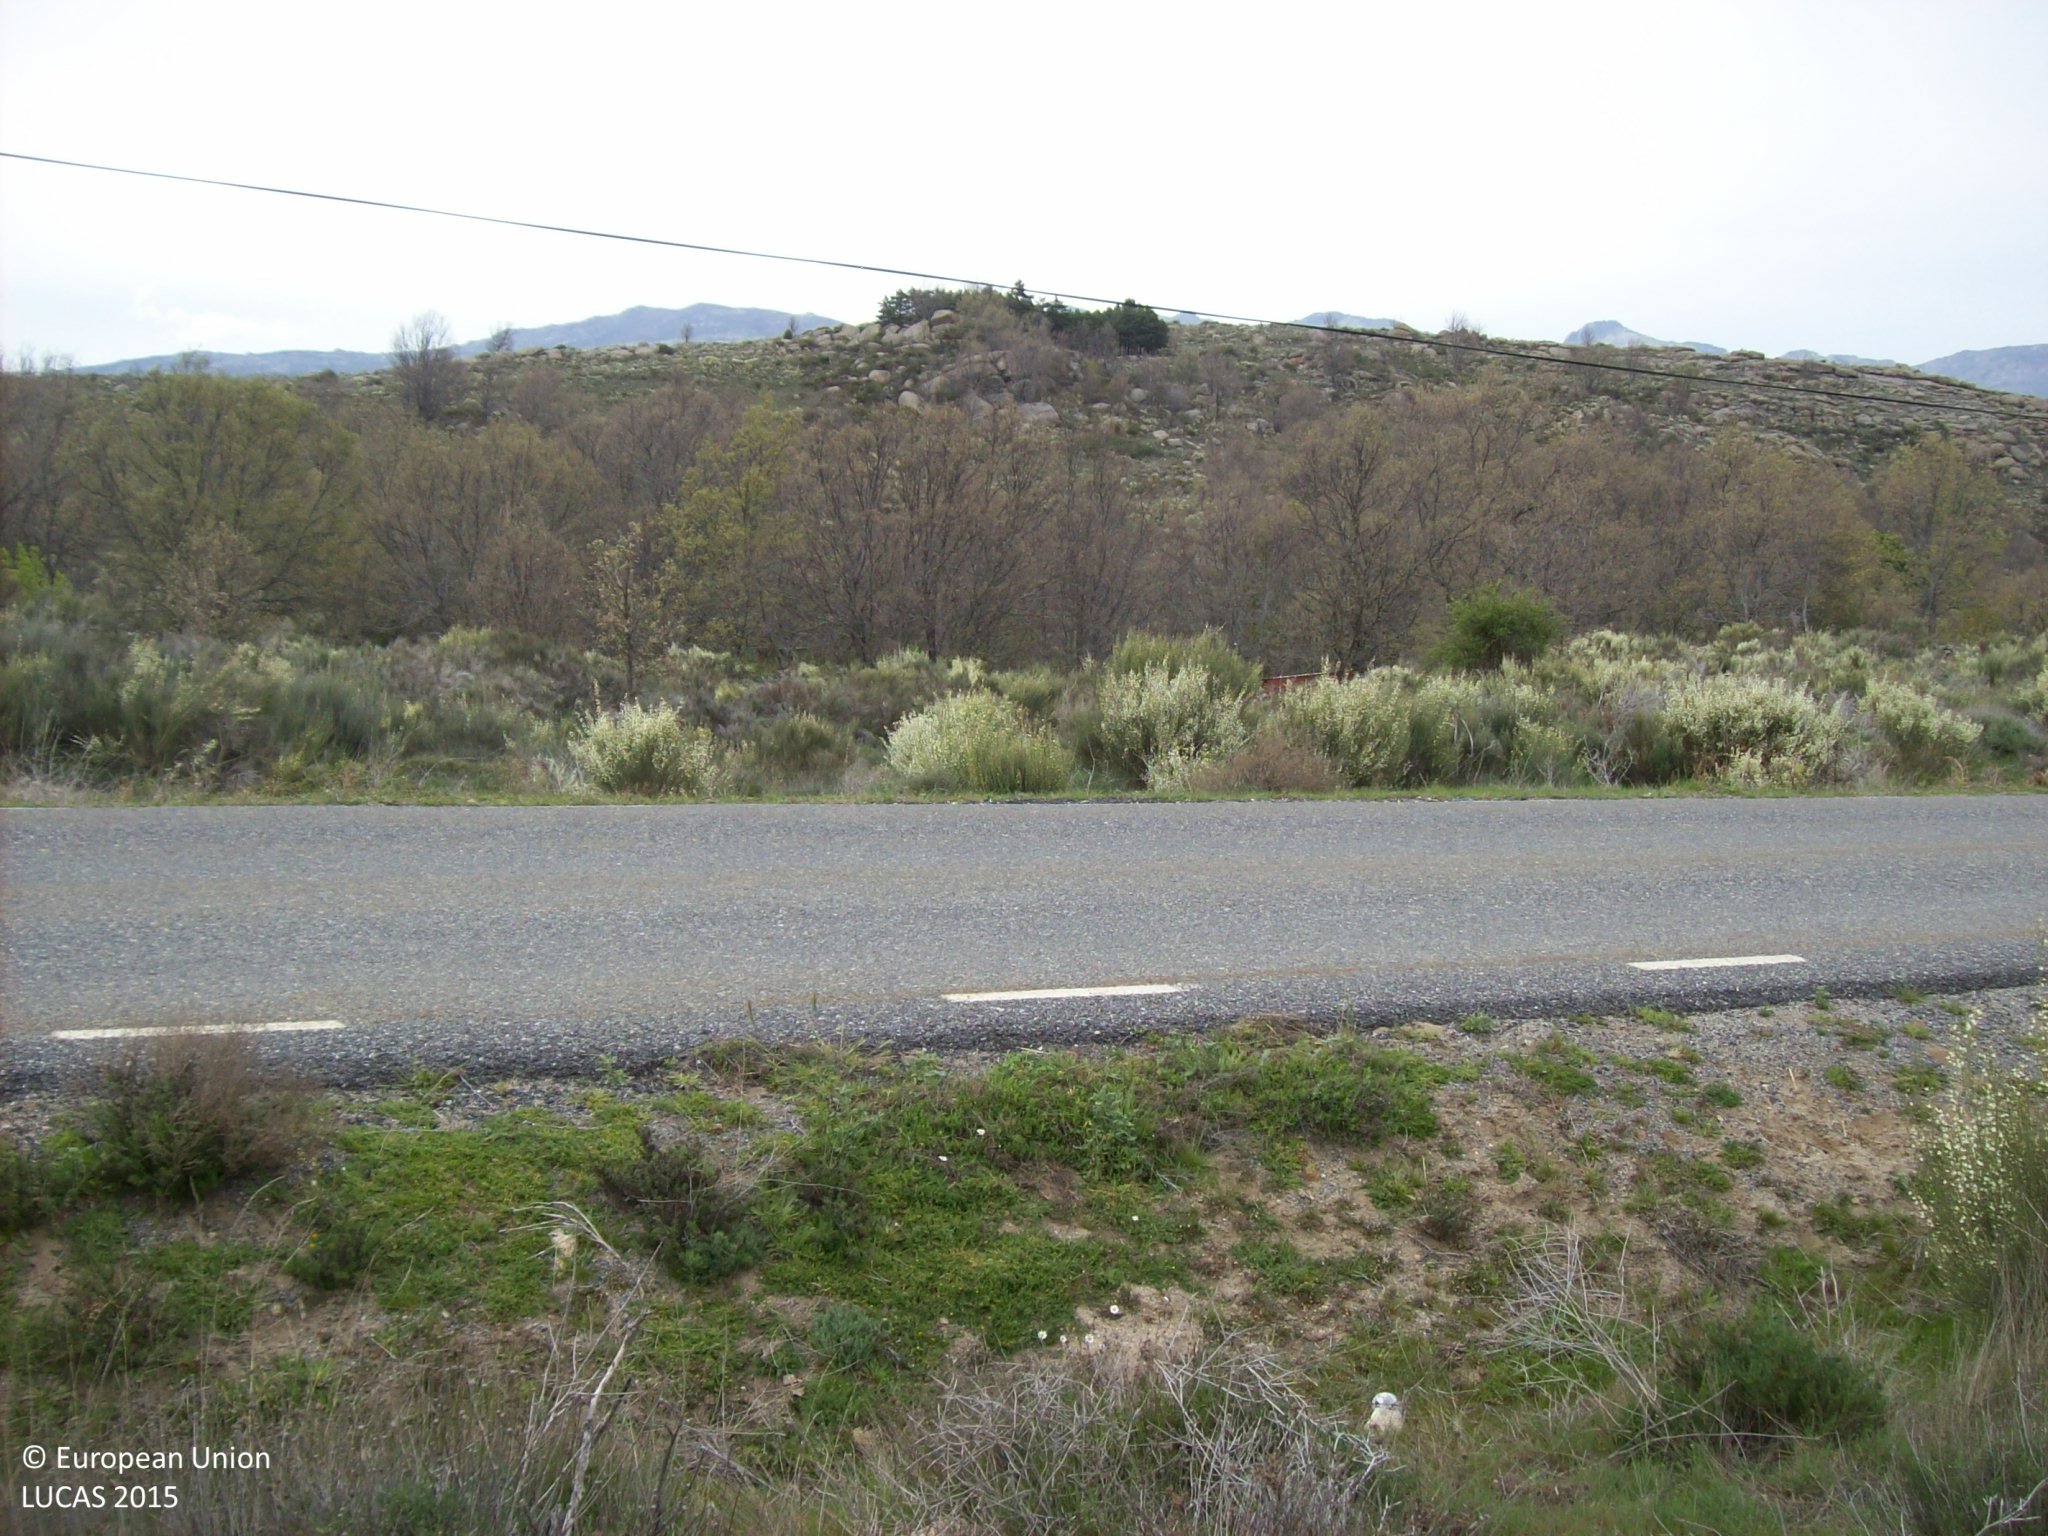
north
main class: Shrubland
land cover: Shrubland with sparse tree cover
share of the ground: > 75 %
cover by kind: shrubs 60 %, herbaceous plants 20 %, broadleaved forest trees 5 %
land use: Semi-natural and natural areas not in use
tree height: < 5 m
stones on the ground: < 10 %
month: April
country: ES
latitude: 40.3735
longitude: -4.8827
